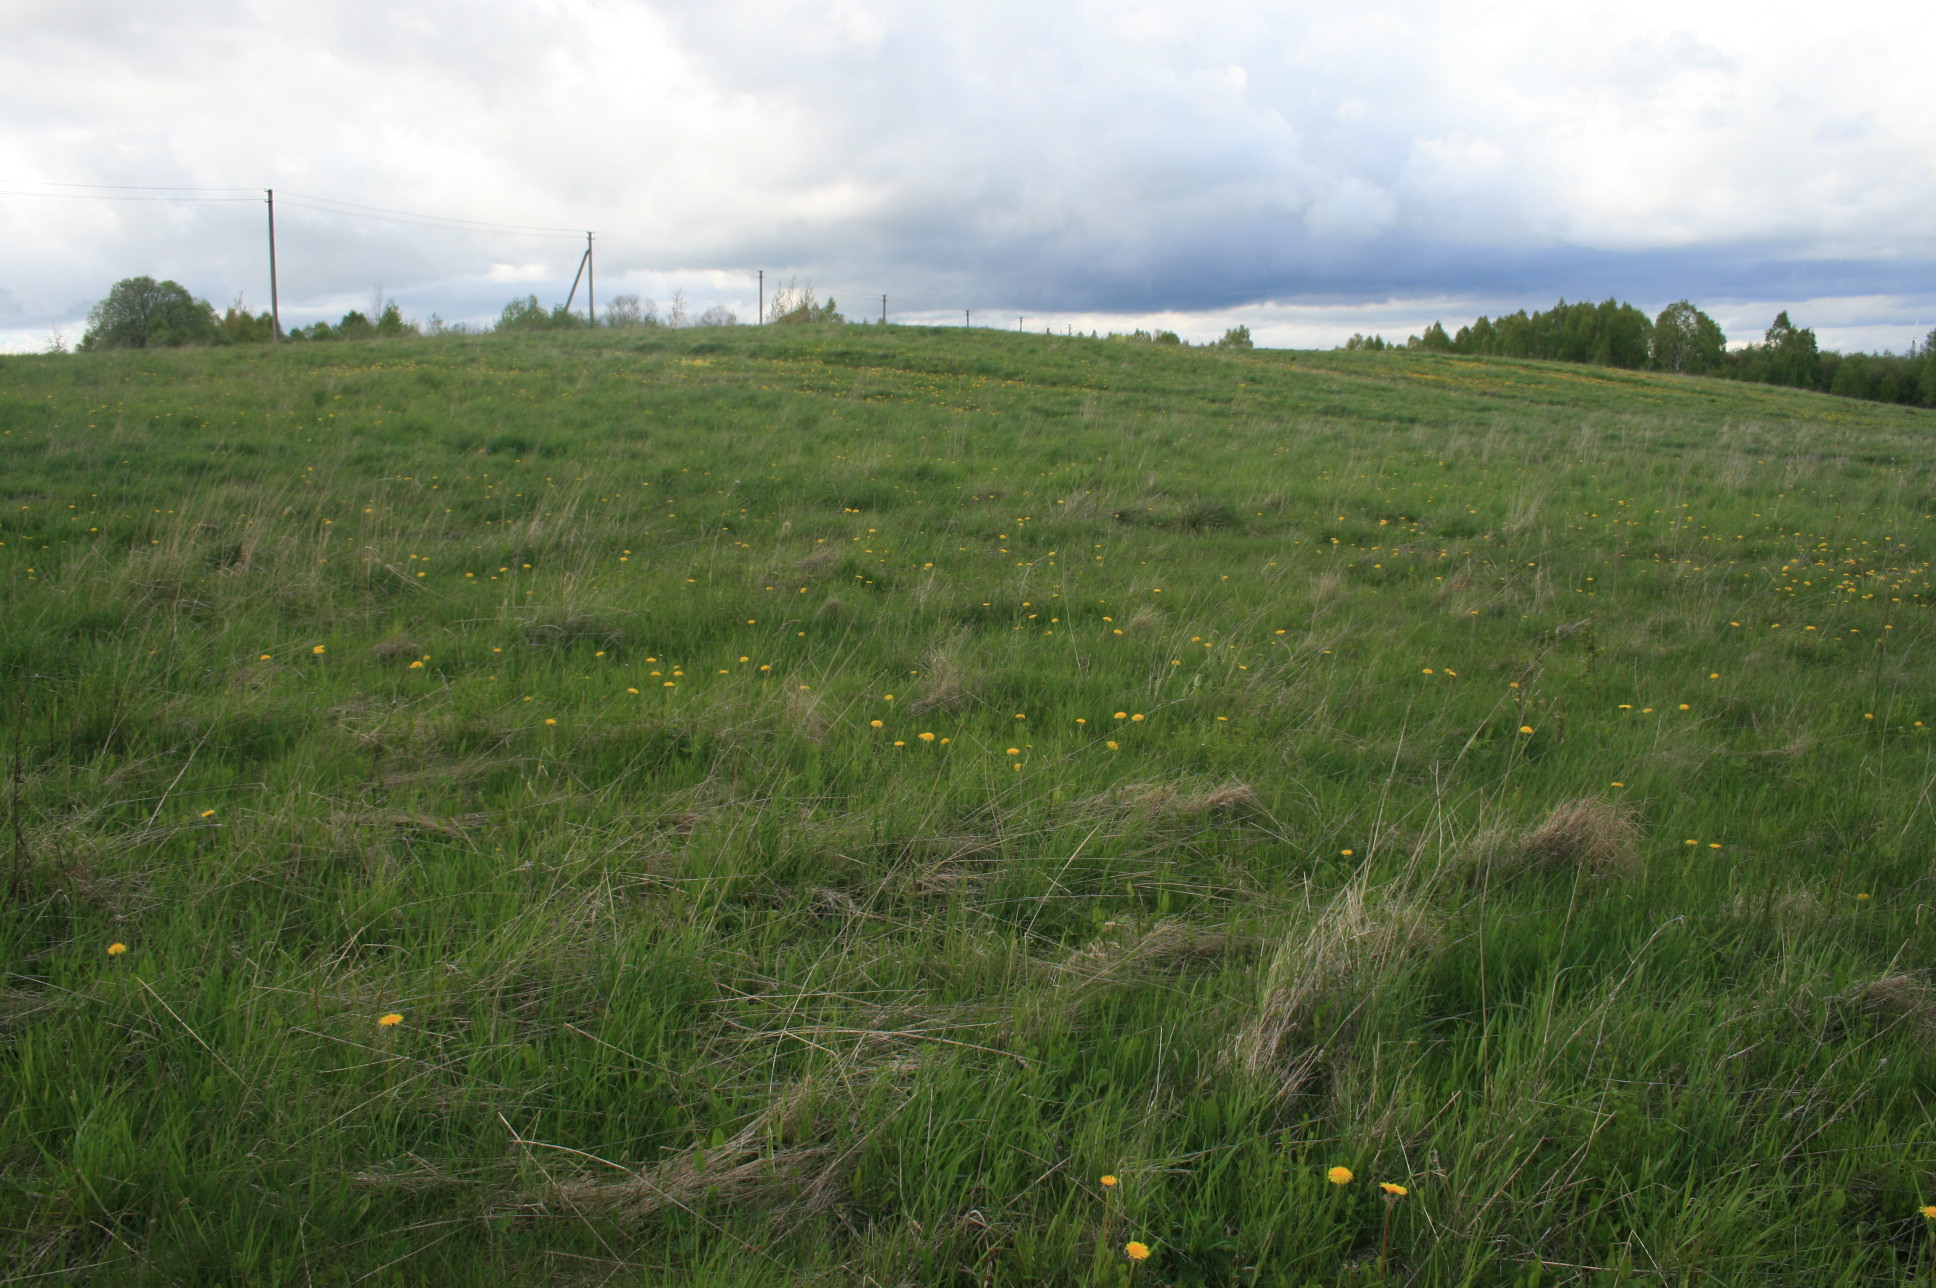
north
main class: Grassland
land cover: Grassland without tree/shrub cover
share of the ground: > 75 %
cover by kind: herbaceous plants 100 %
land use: Agriculture (excluding fallow land and kitchen gardens)
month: May
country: LT
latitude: 56.1783
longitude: 22.0855
